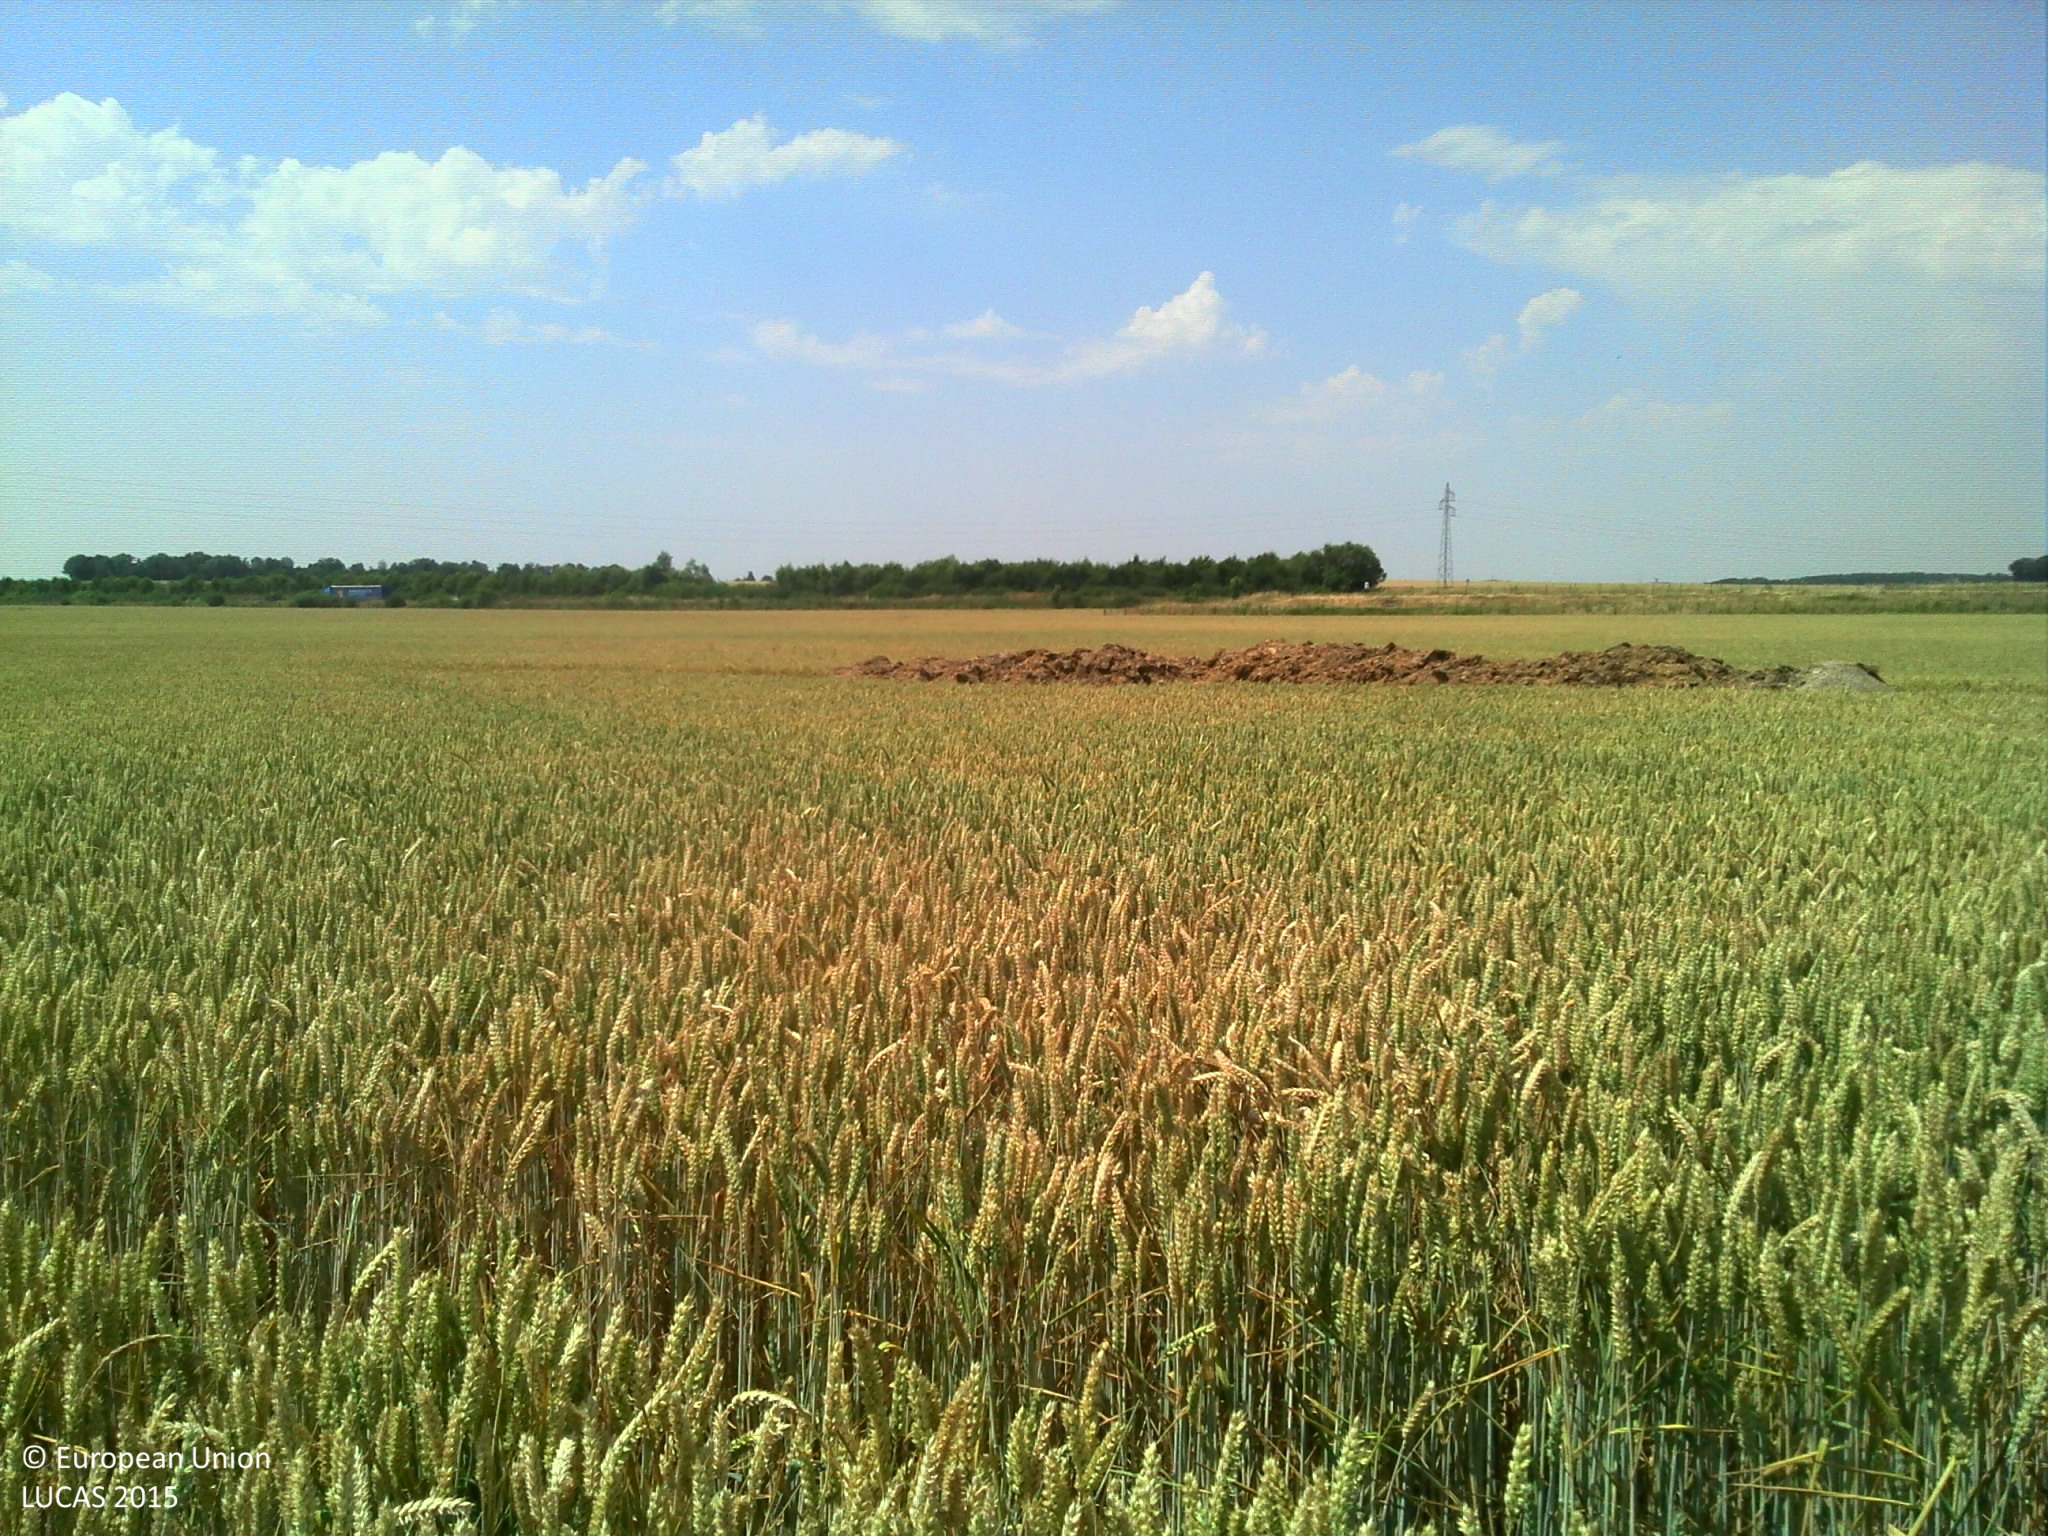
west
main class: Cropland
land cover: Common wheat
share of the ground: > 75 %
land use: Agriculture (excluding fallow land and kitchen gardens)
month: July
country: FR
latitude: 48.9211
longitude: 1.2050
